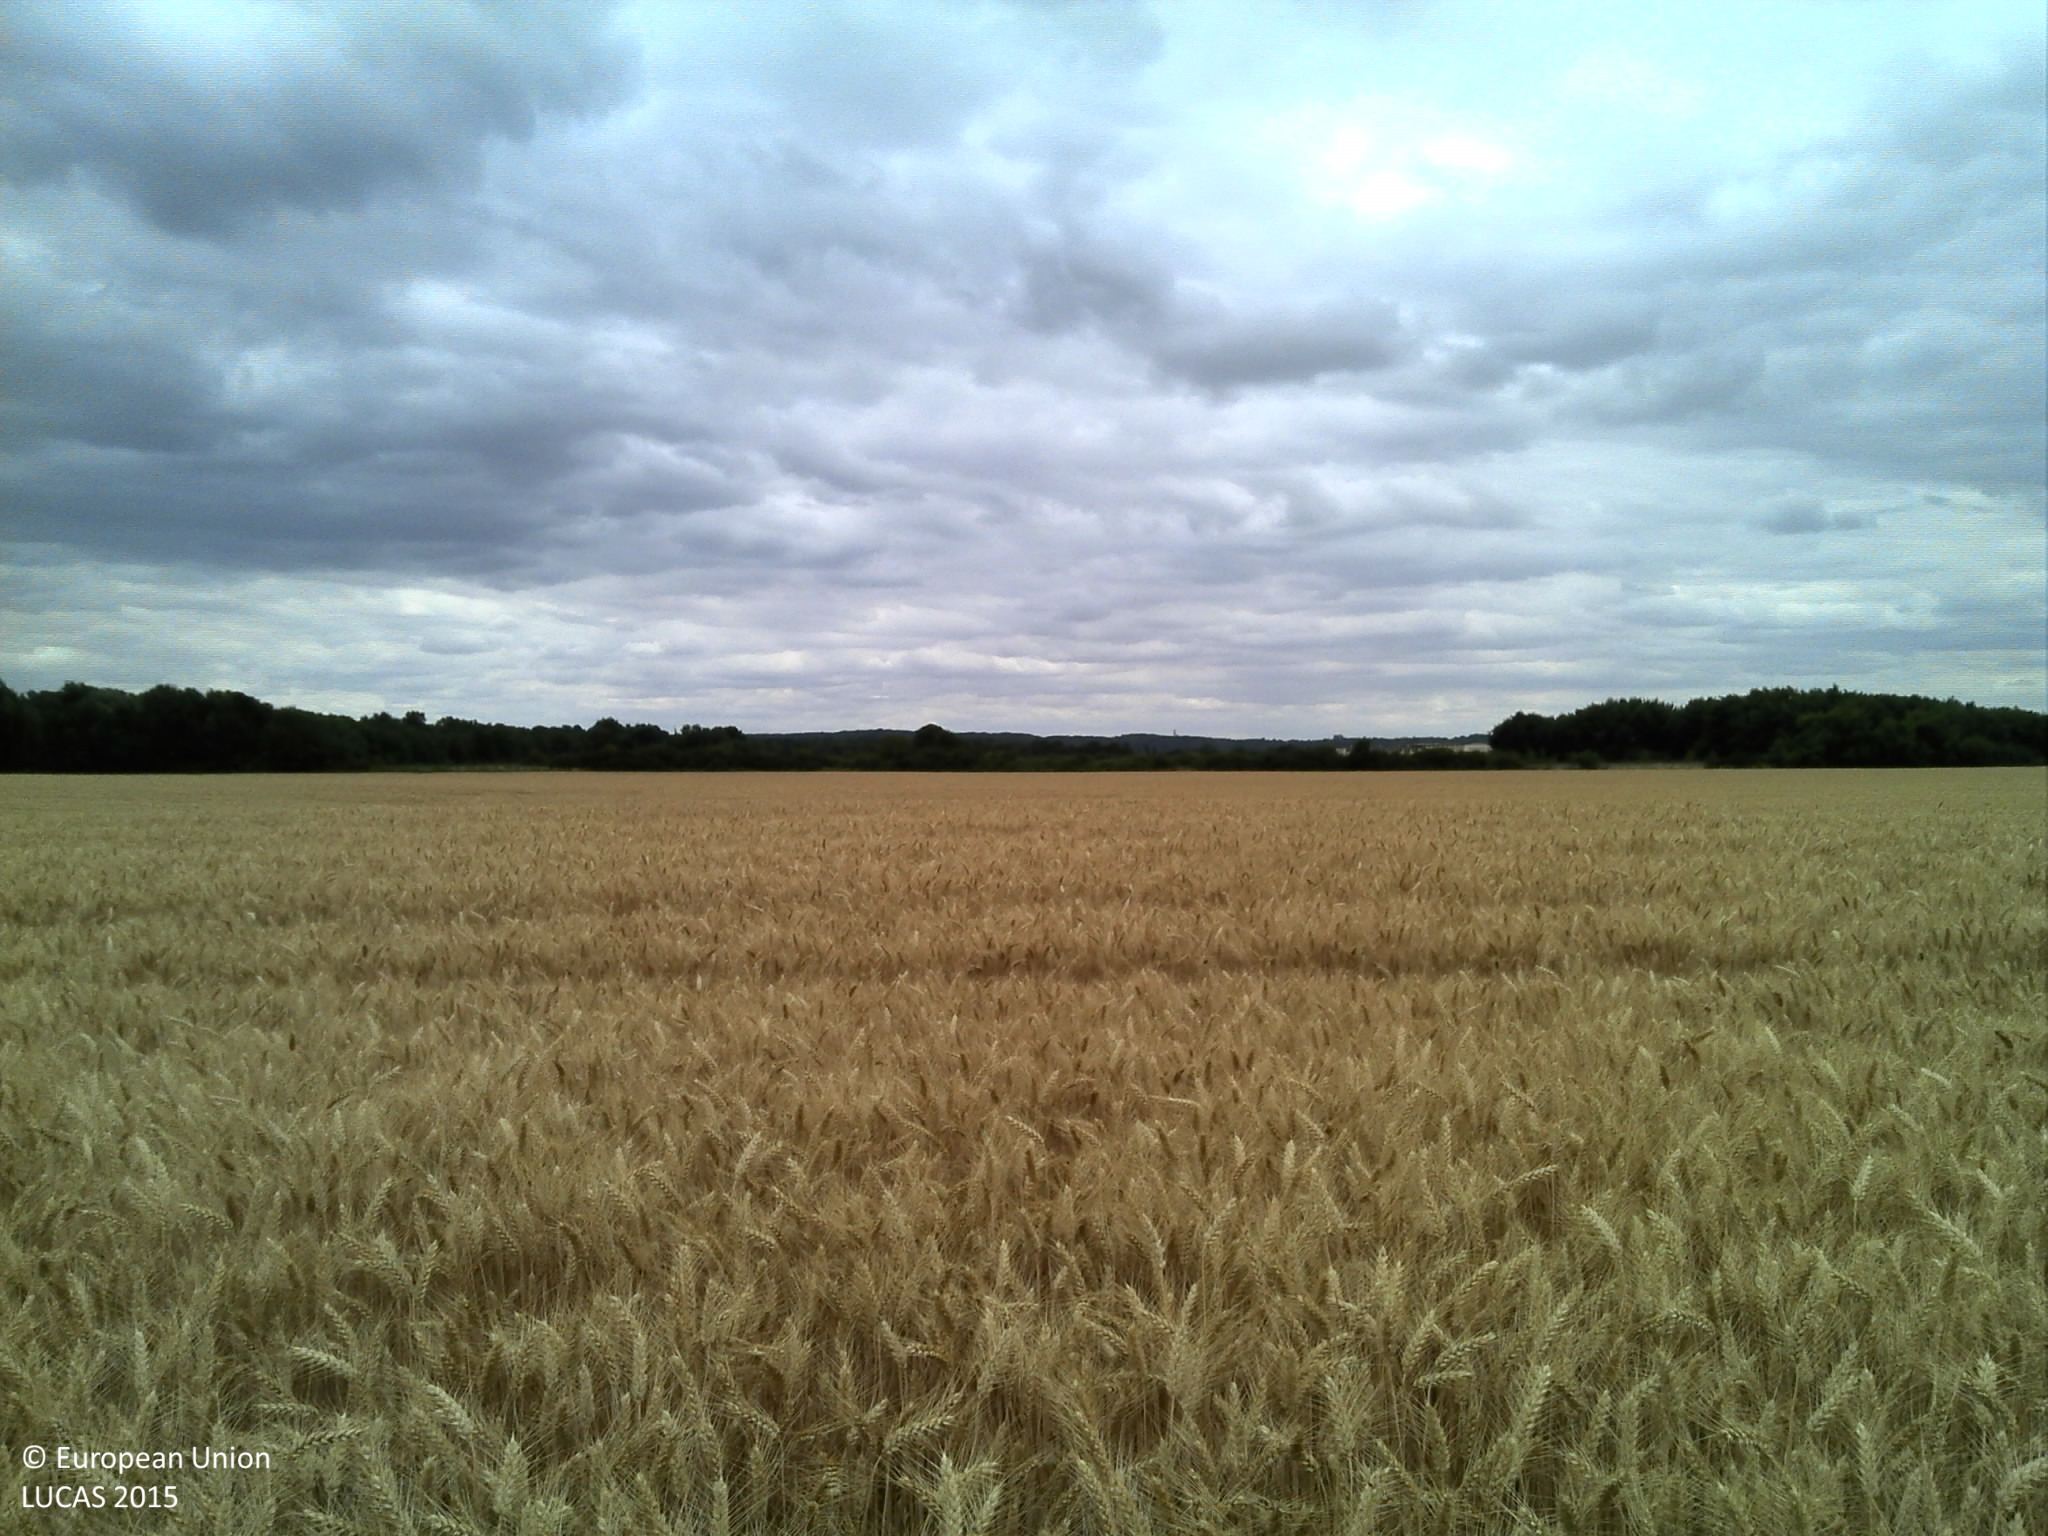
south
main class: Cropland
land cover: Durum wheat
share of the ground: > 75 %
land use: Agriculture (excluding fallow land and kitchen gardens)
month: July
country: FR
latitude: 48.5442
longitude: 2.4714
